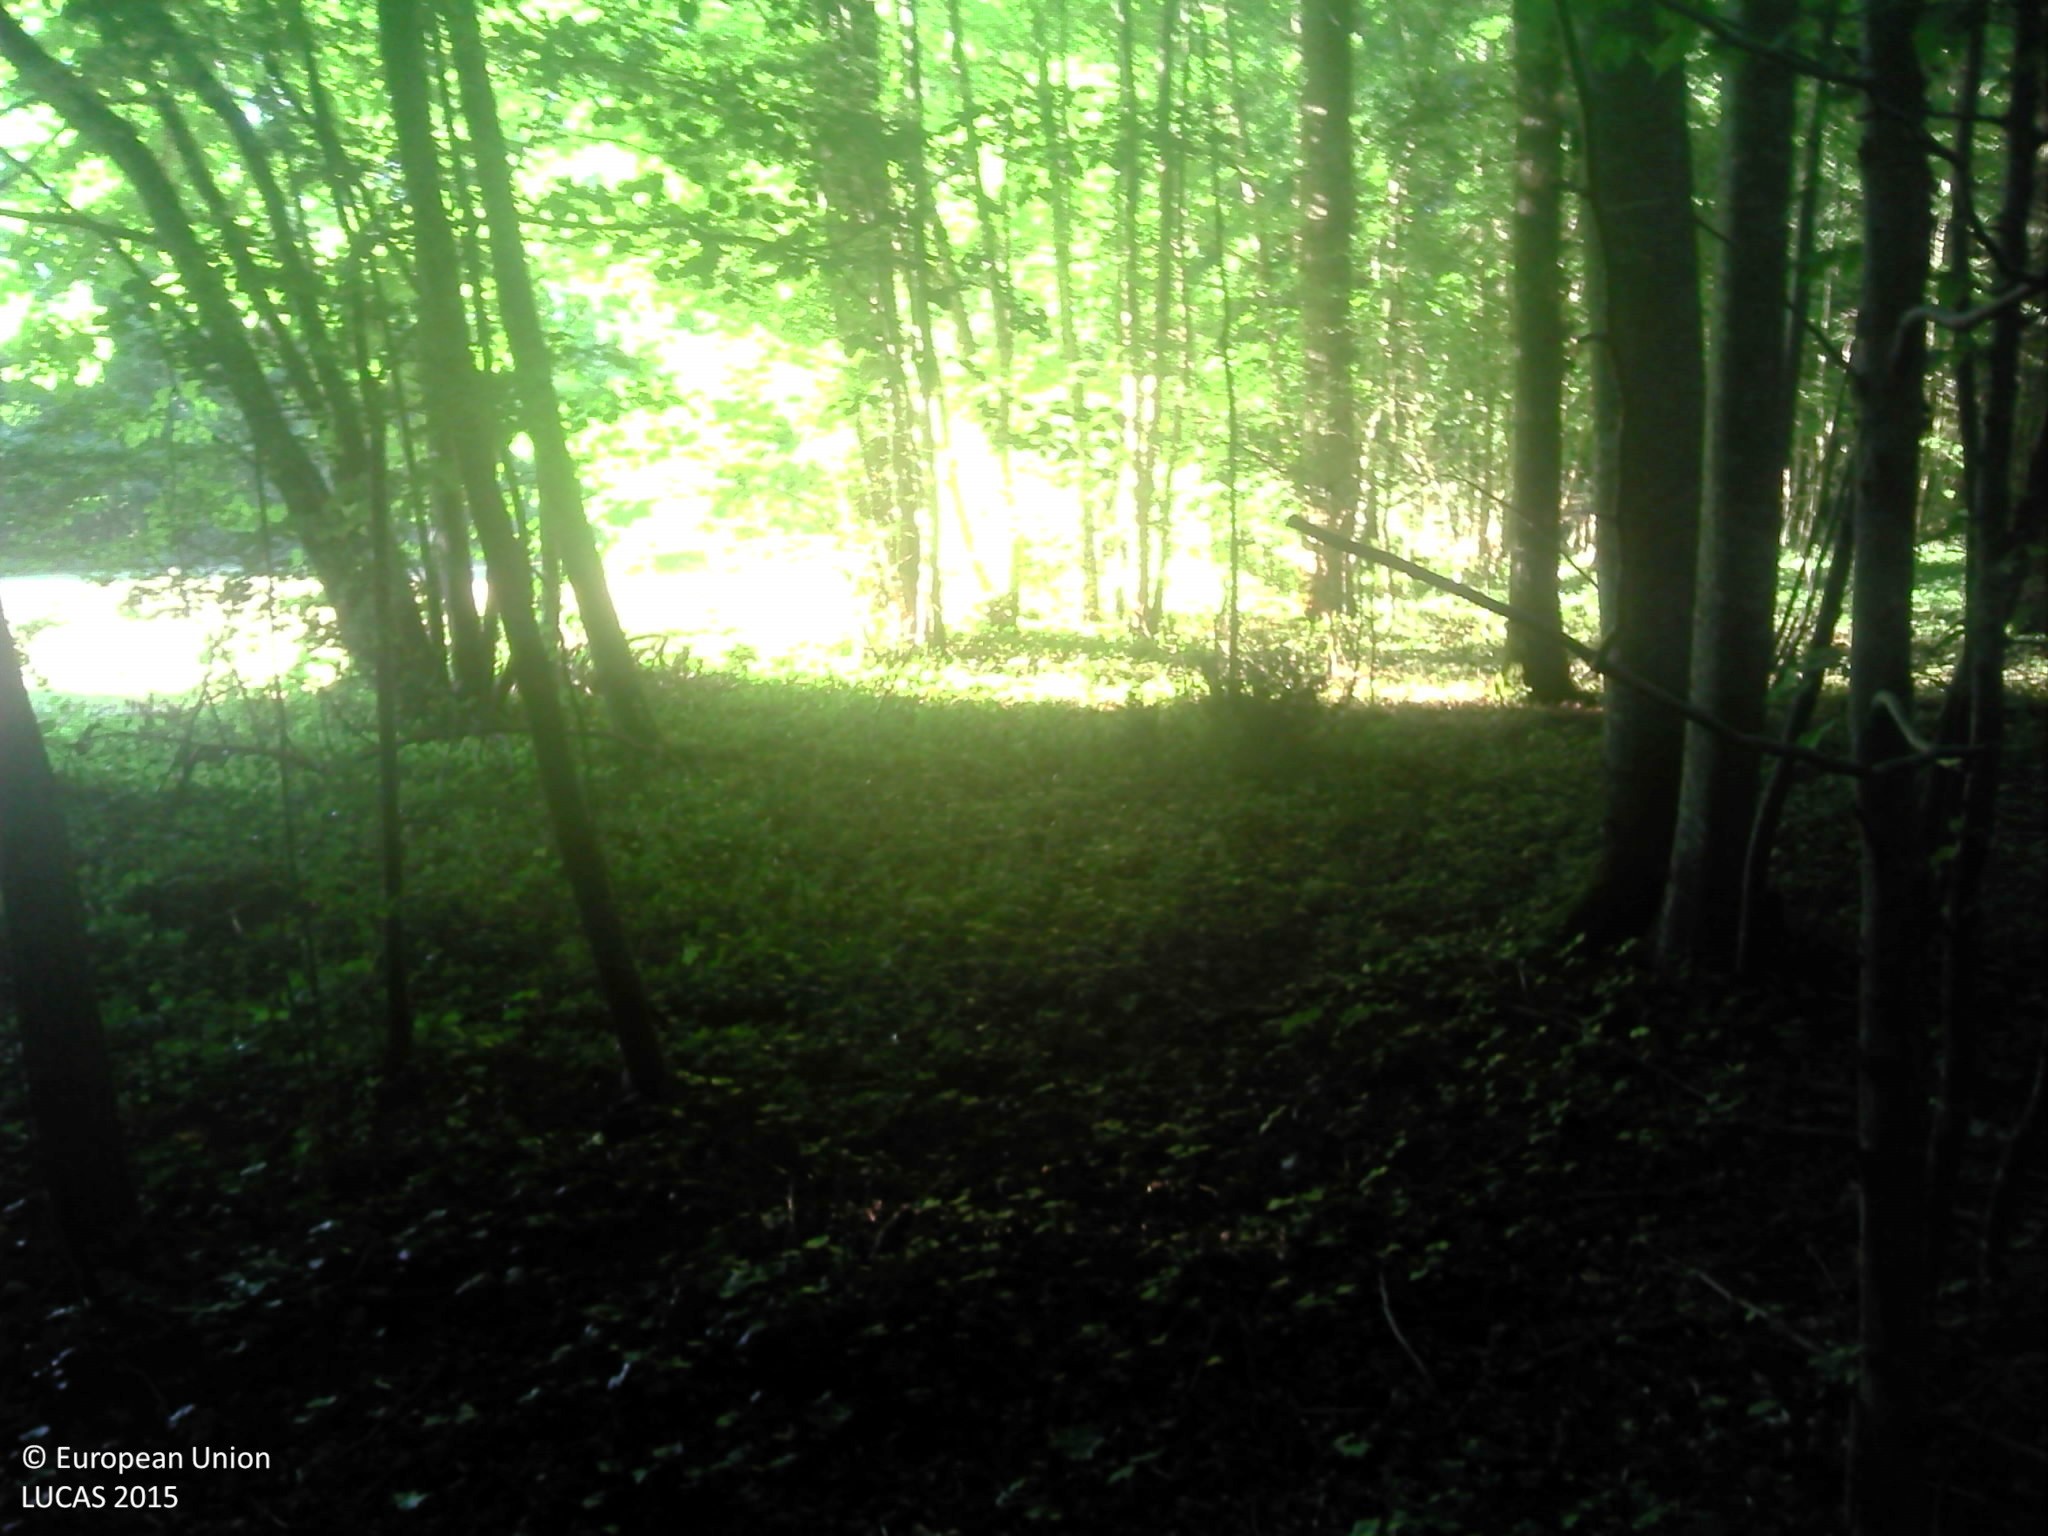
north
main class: Woodland
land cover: Broadleaved woodland
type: mesophytic deciduous forest
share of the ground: > 75 %
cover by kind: unconsolidated bare surface 60 %, broadleaved forest trees 20 %, herbaceous plants 20 %
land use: Forestry
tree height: > 5 m
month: June
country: FR
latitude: 47.2345
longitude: 1.3873
